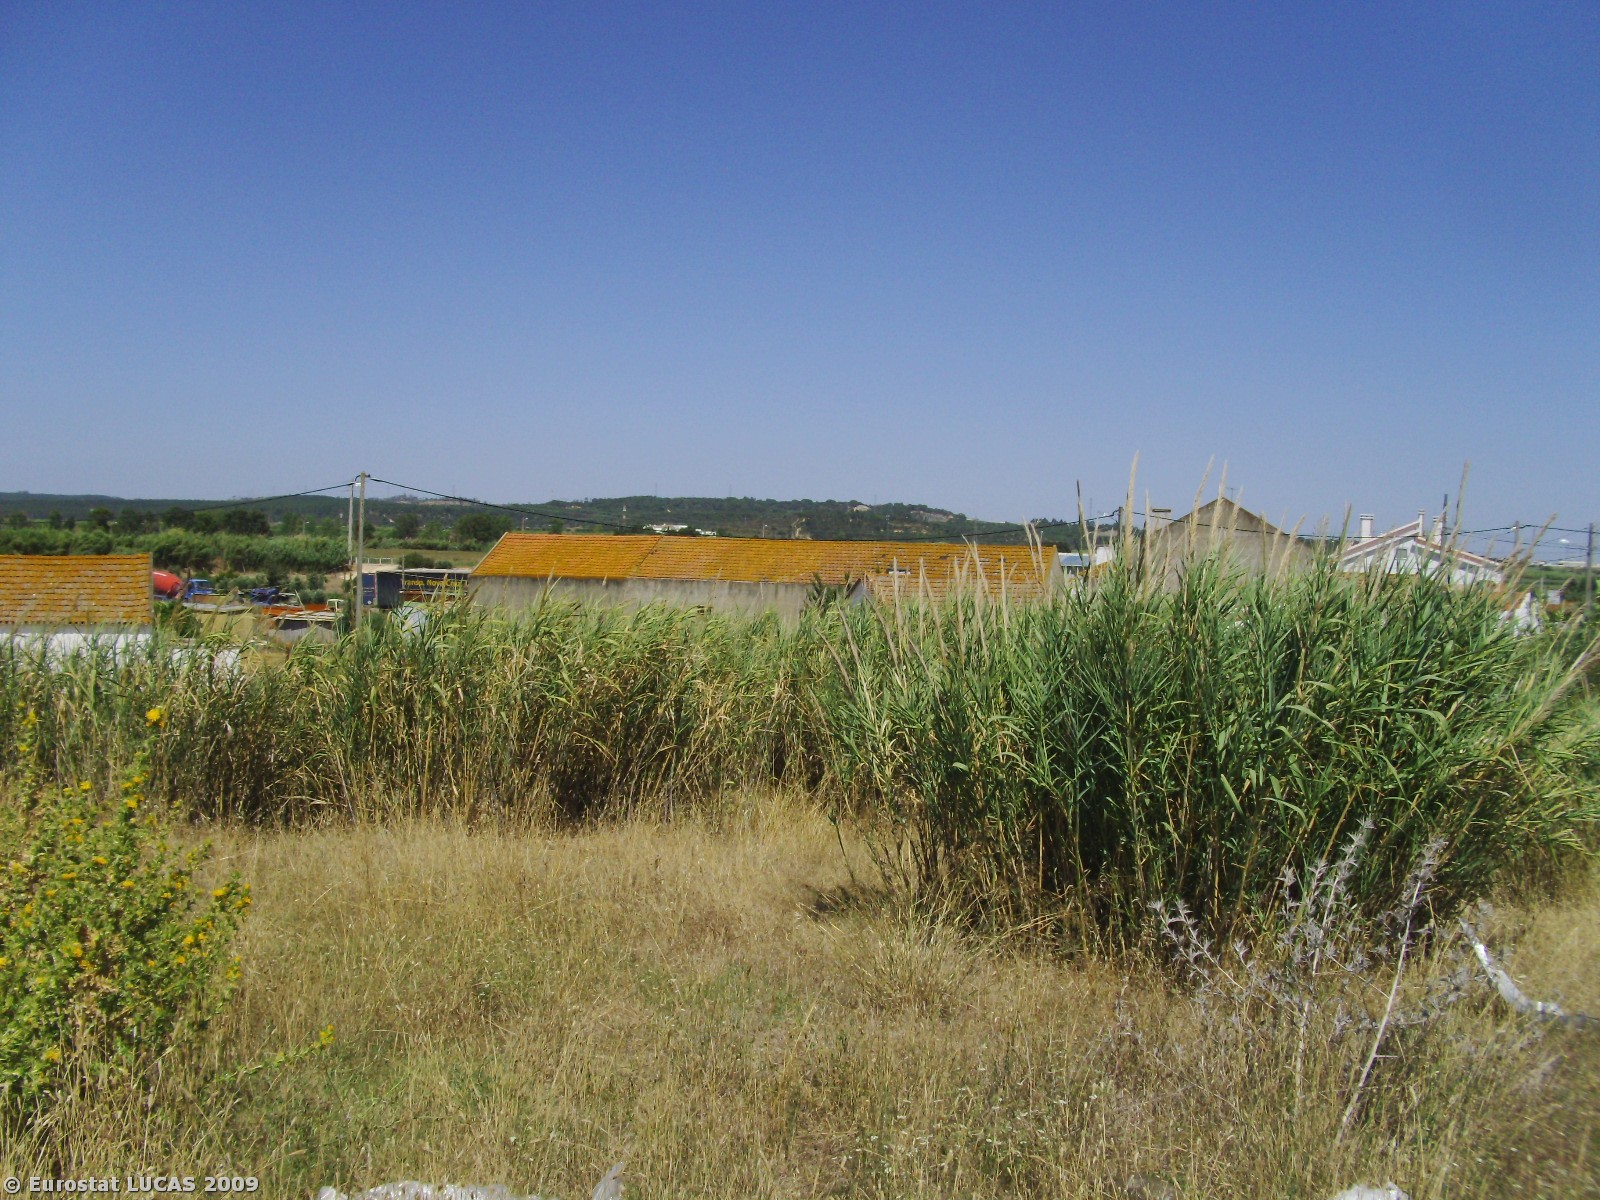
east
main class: Grassland
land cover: Spontaneously vegetated surfaces
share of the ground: > 75 %
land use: Unused
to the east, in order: Spontaneously vegetated surfaces; Shrubland without tree cover; Electric lines; Paved roads, cycling and walking lanes; Artificial constructions in urban areas; Shrubland without tree cover; Fences; Electric lines; Paved roads, cycling and walking lanes; Other structural elements; Shrubland with sparse tree cover; Bare land
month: July
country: PT
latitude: 39.0461
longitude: -8.9679
